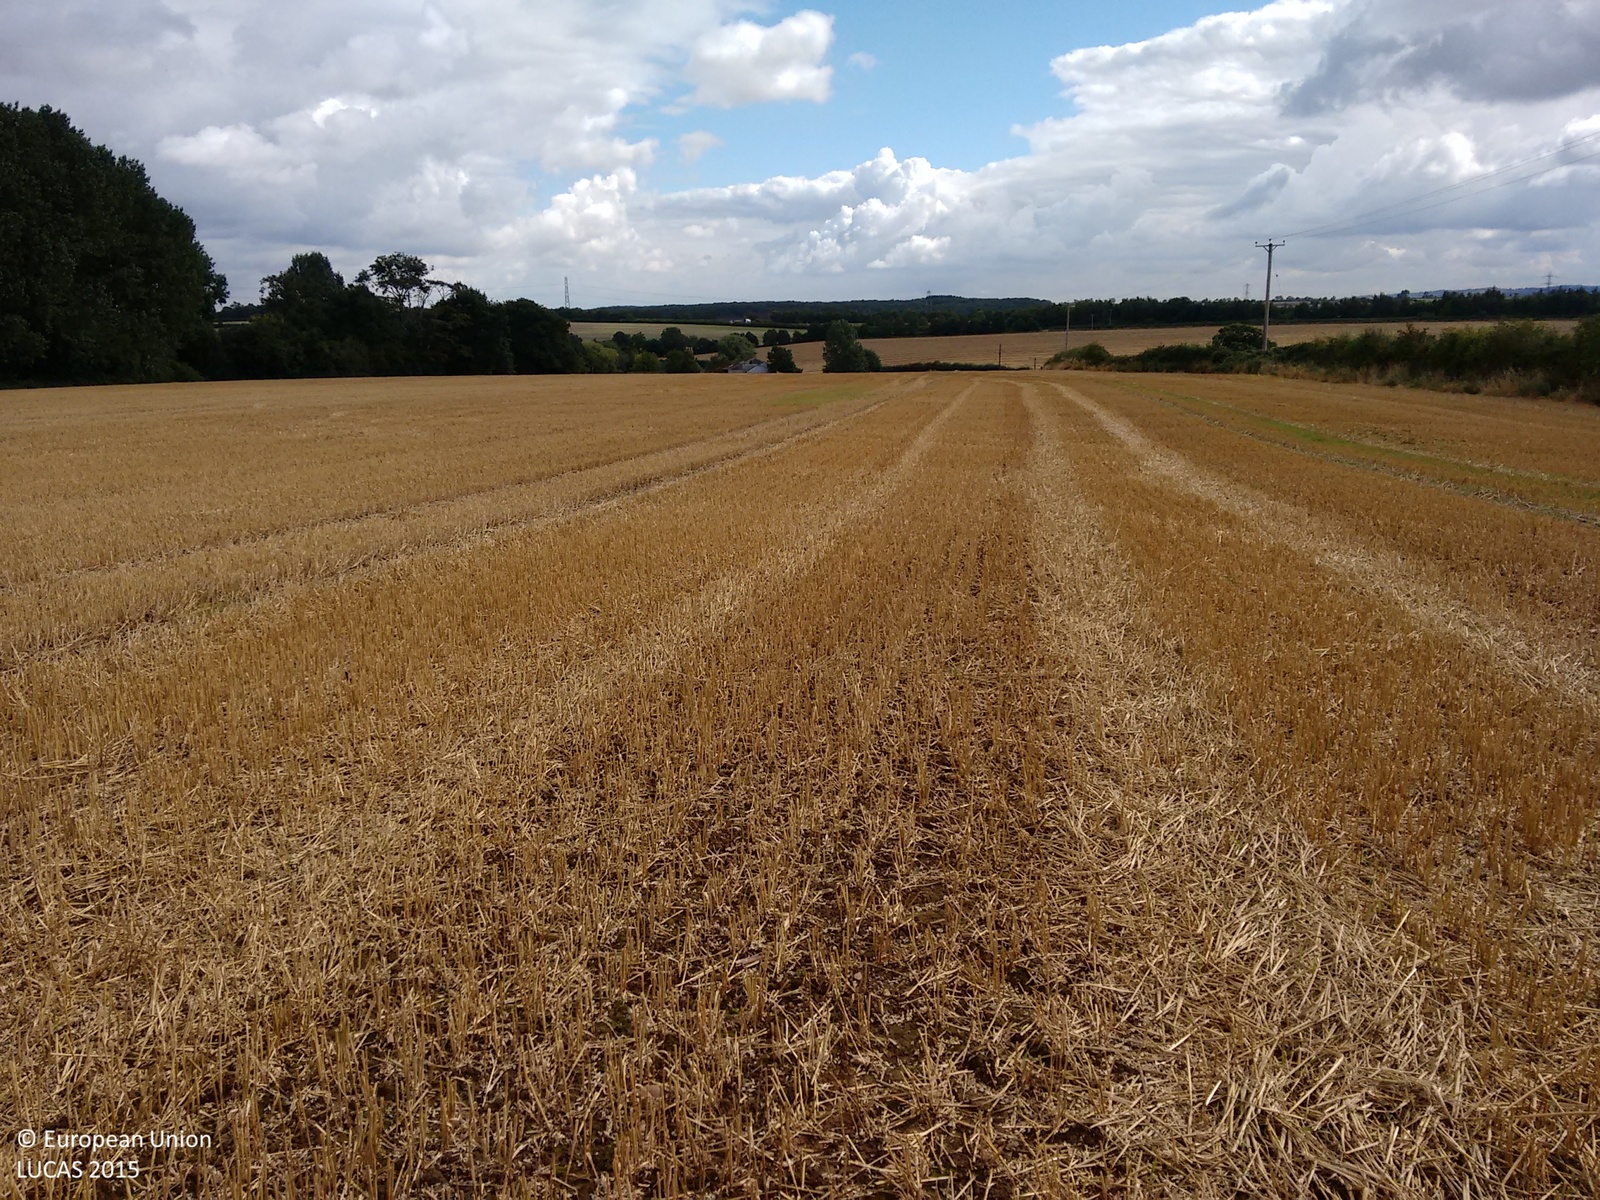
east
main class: Cropland
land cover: Common wheat
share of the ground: > 75 %
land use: Agriculture (excluding fallow land and kitchen gardens)
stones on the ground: < 10 %
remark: Harvested field
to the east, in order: Common wheat
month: September
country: GB
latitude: 52.7867
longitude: -1.4224
